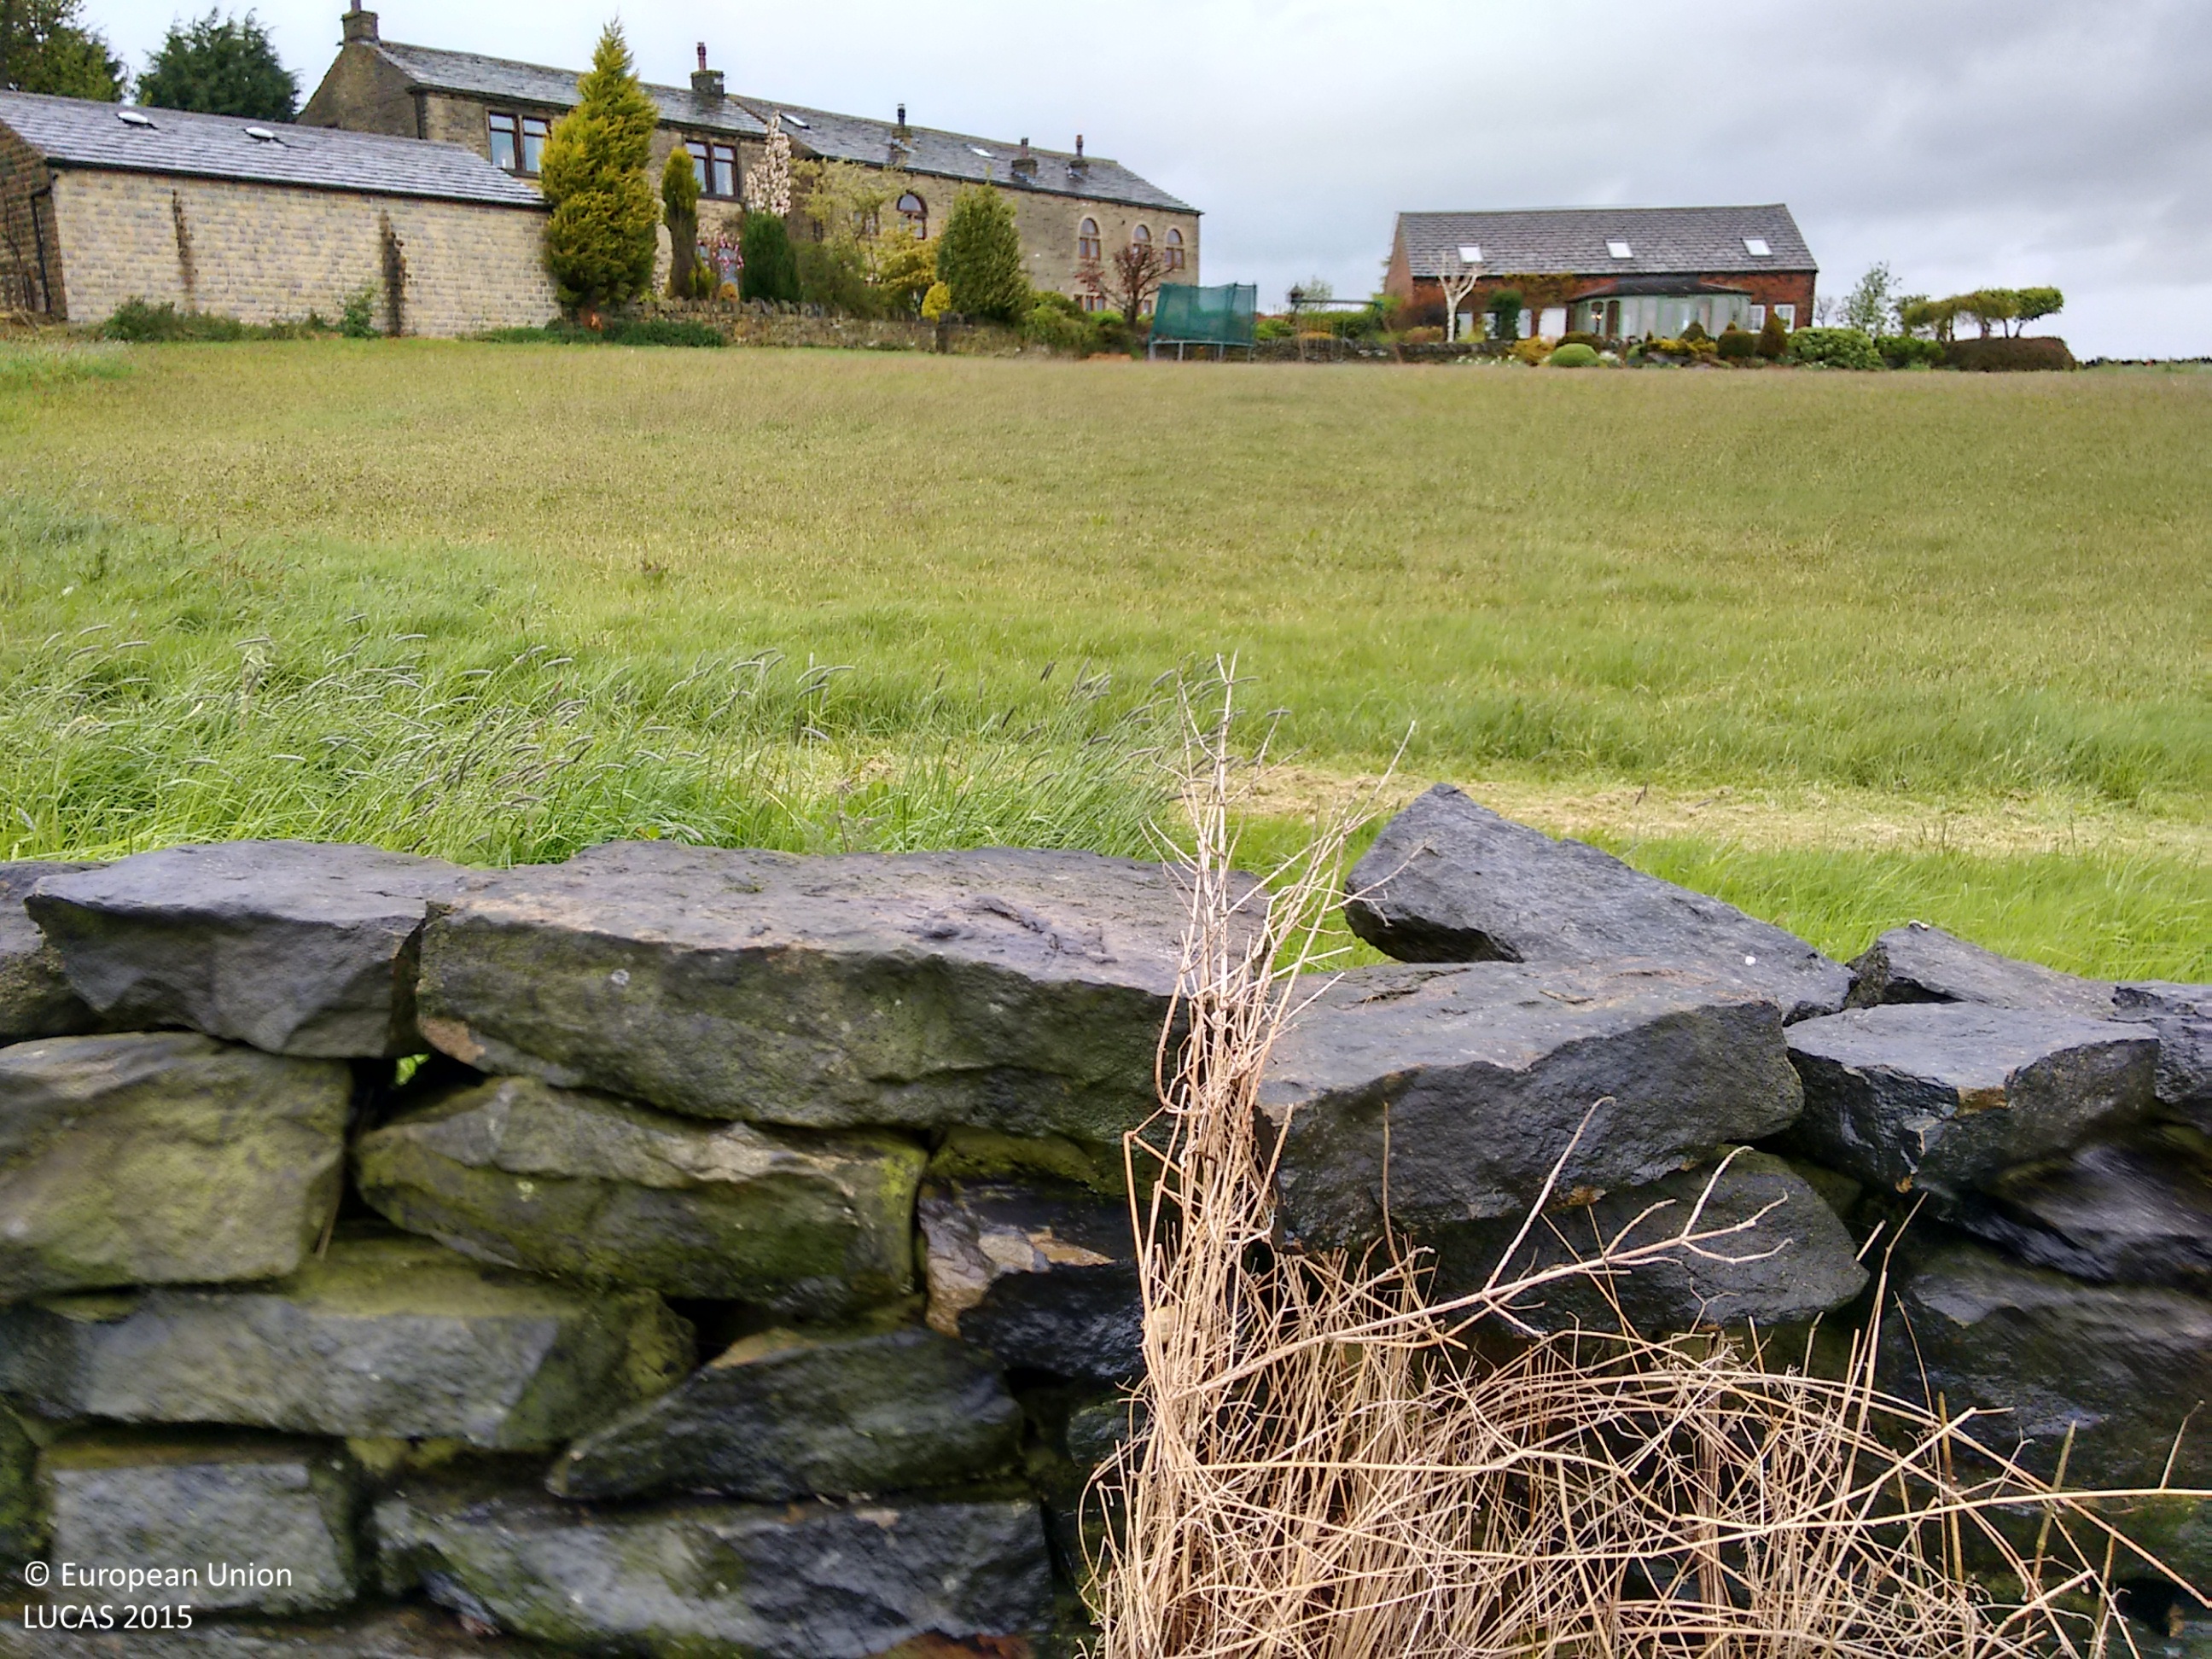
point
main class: Grassland
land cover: Grassland without tree/shrub cover
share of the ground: > 75 %
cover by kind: herbaceous plants 100 %
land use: Agriculture (excluding fallow land and kitchen gardens)
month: May
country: GB
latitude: 53.7108
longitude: -1.8267
